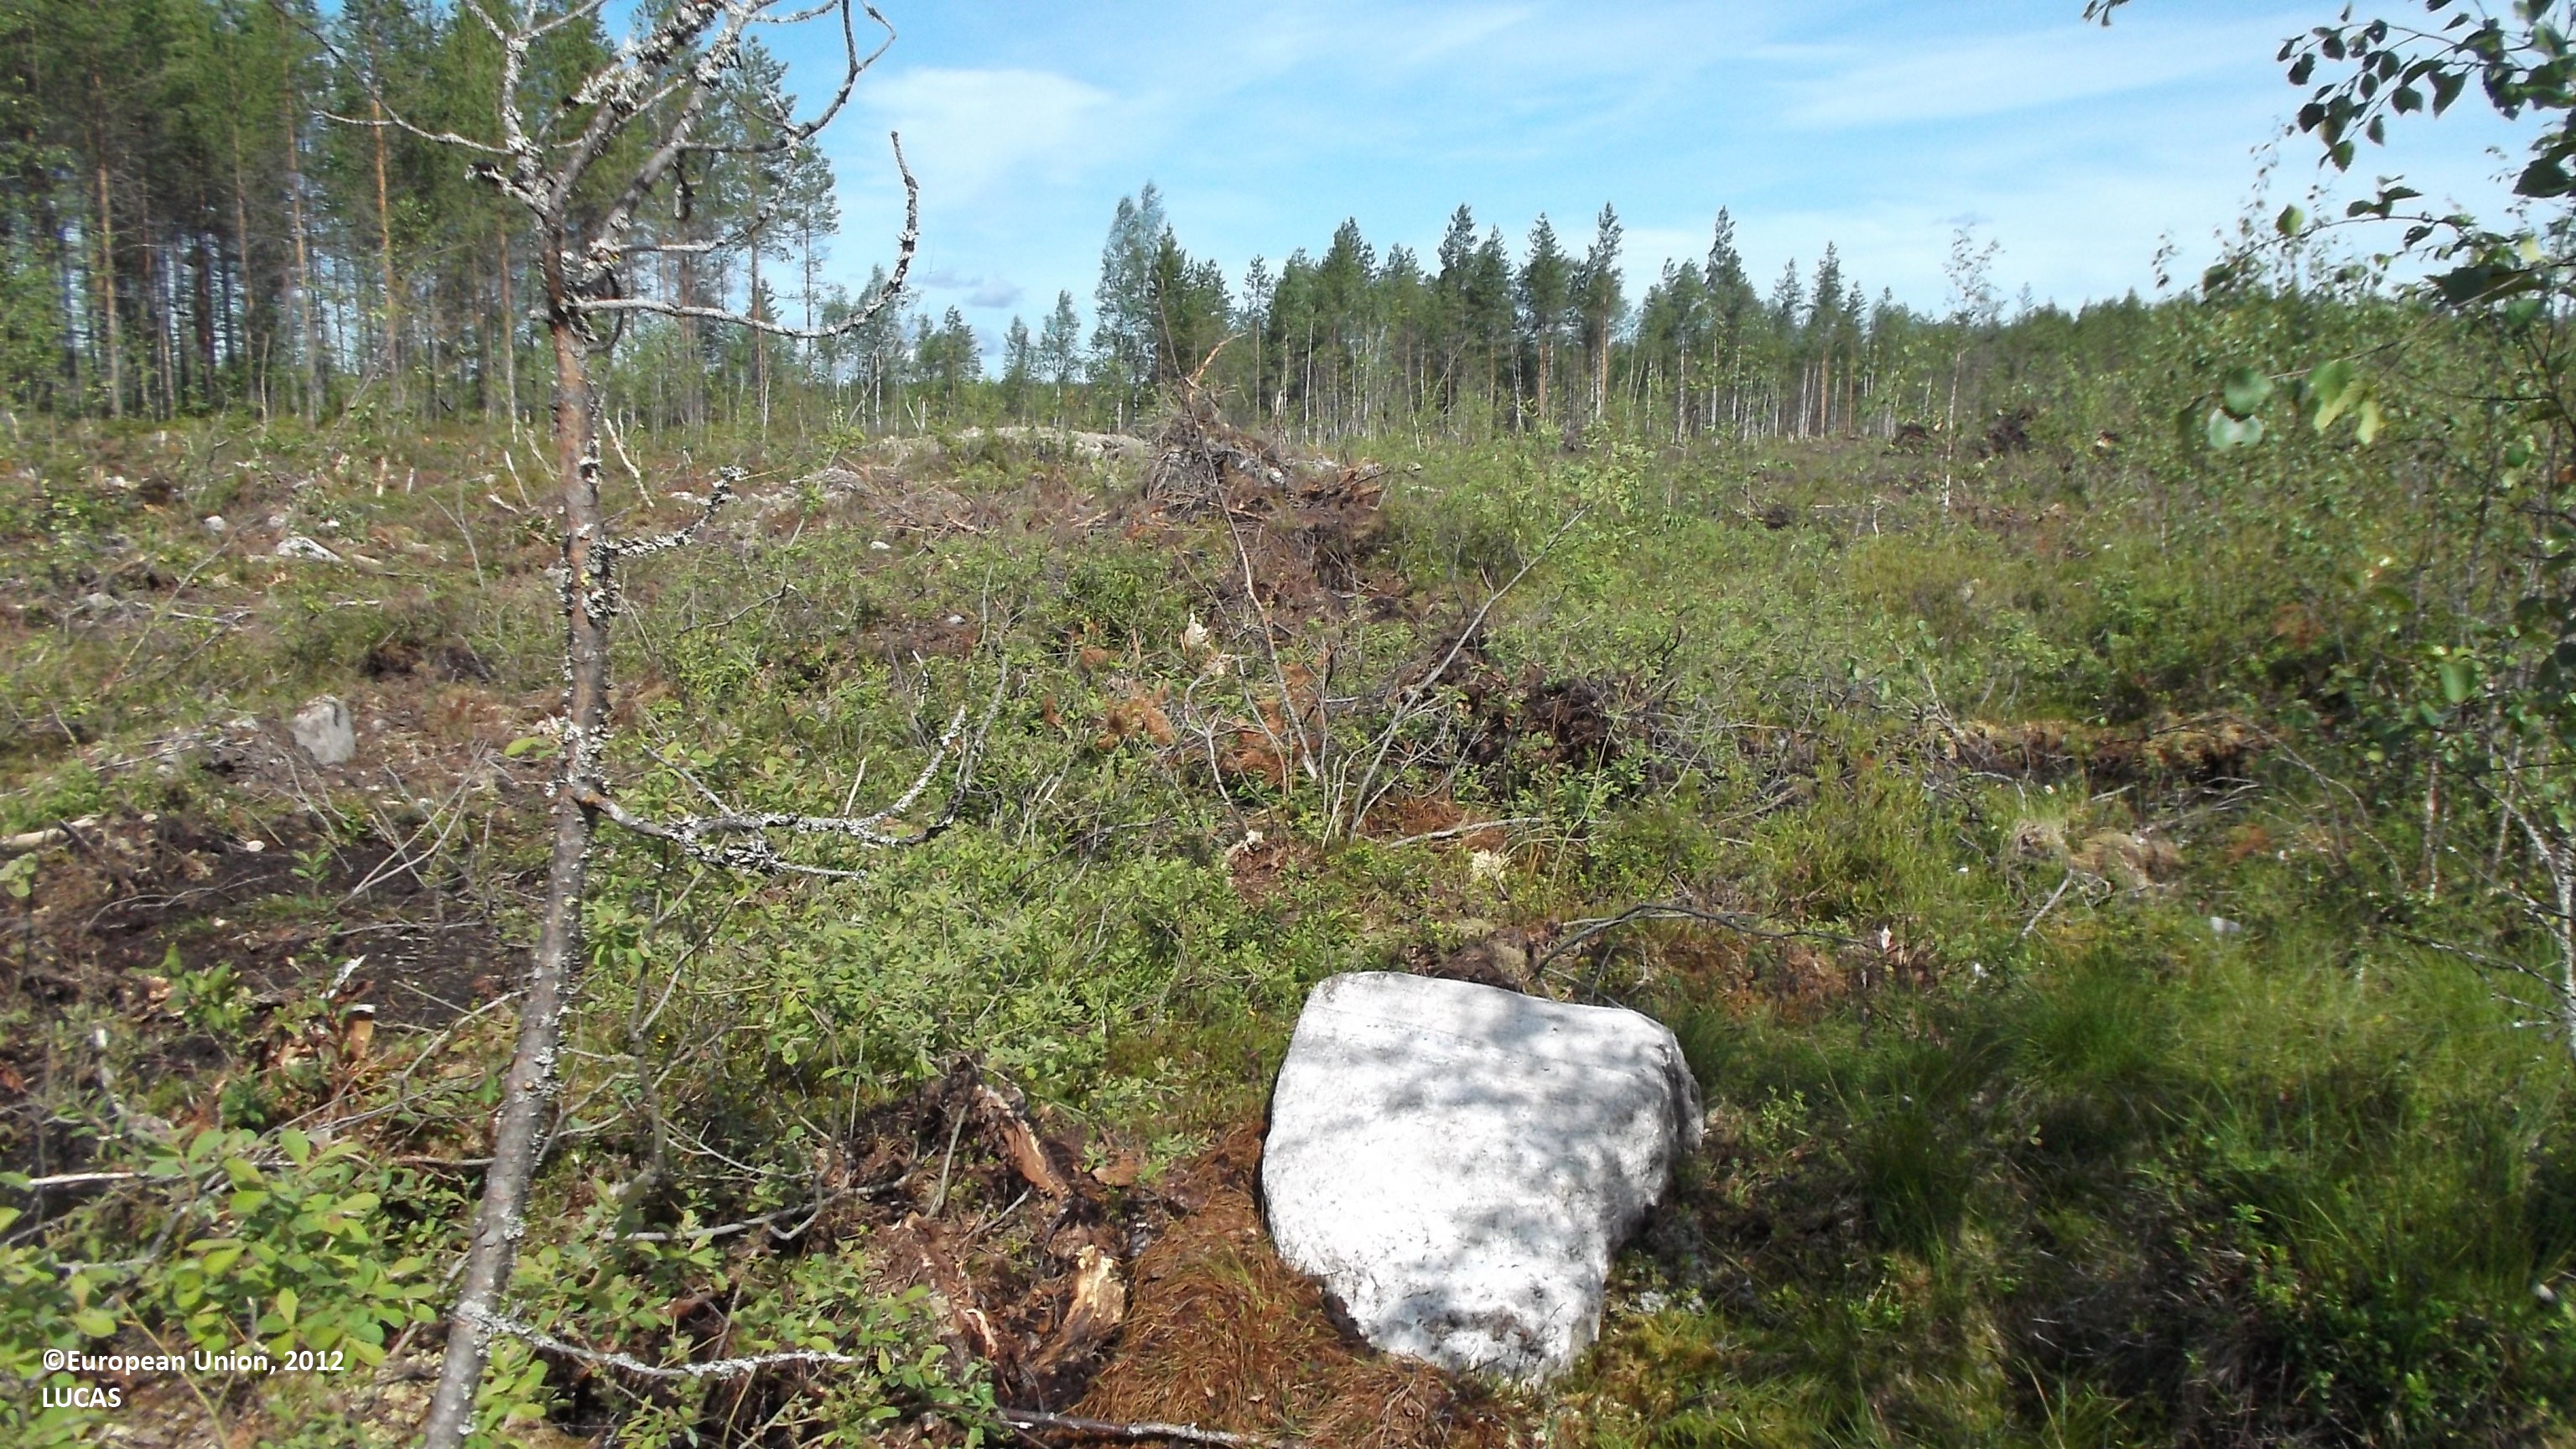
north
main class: Woodland
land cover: Broadleaved woodland
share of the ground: 10 - 25 %
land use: Forestry
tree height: < 5 m
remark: Clear cut
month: July
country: FI
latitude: 63.5197
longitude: 23.9598
